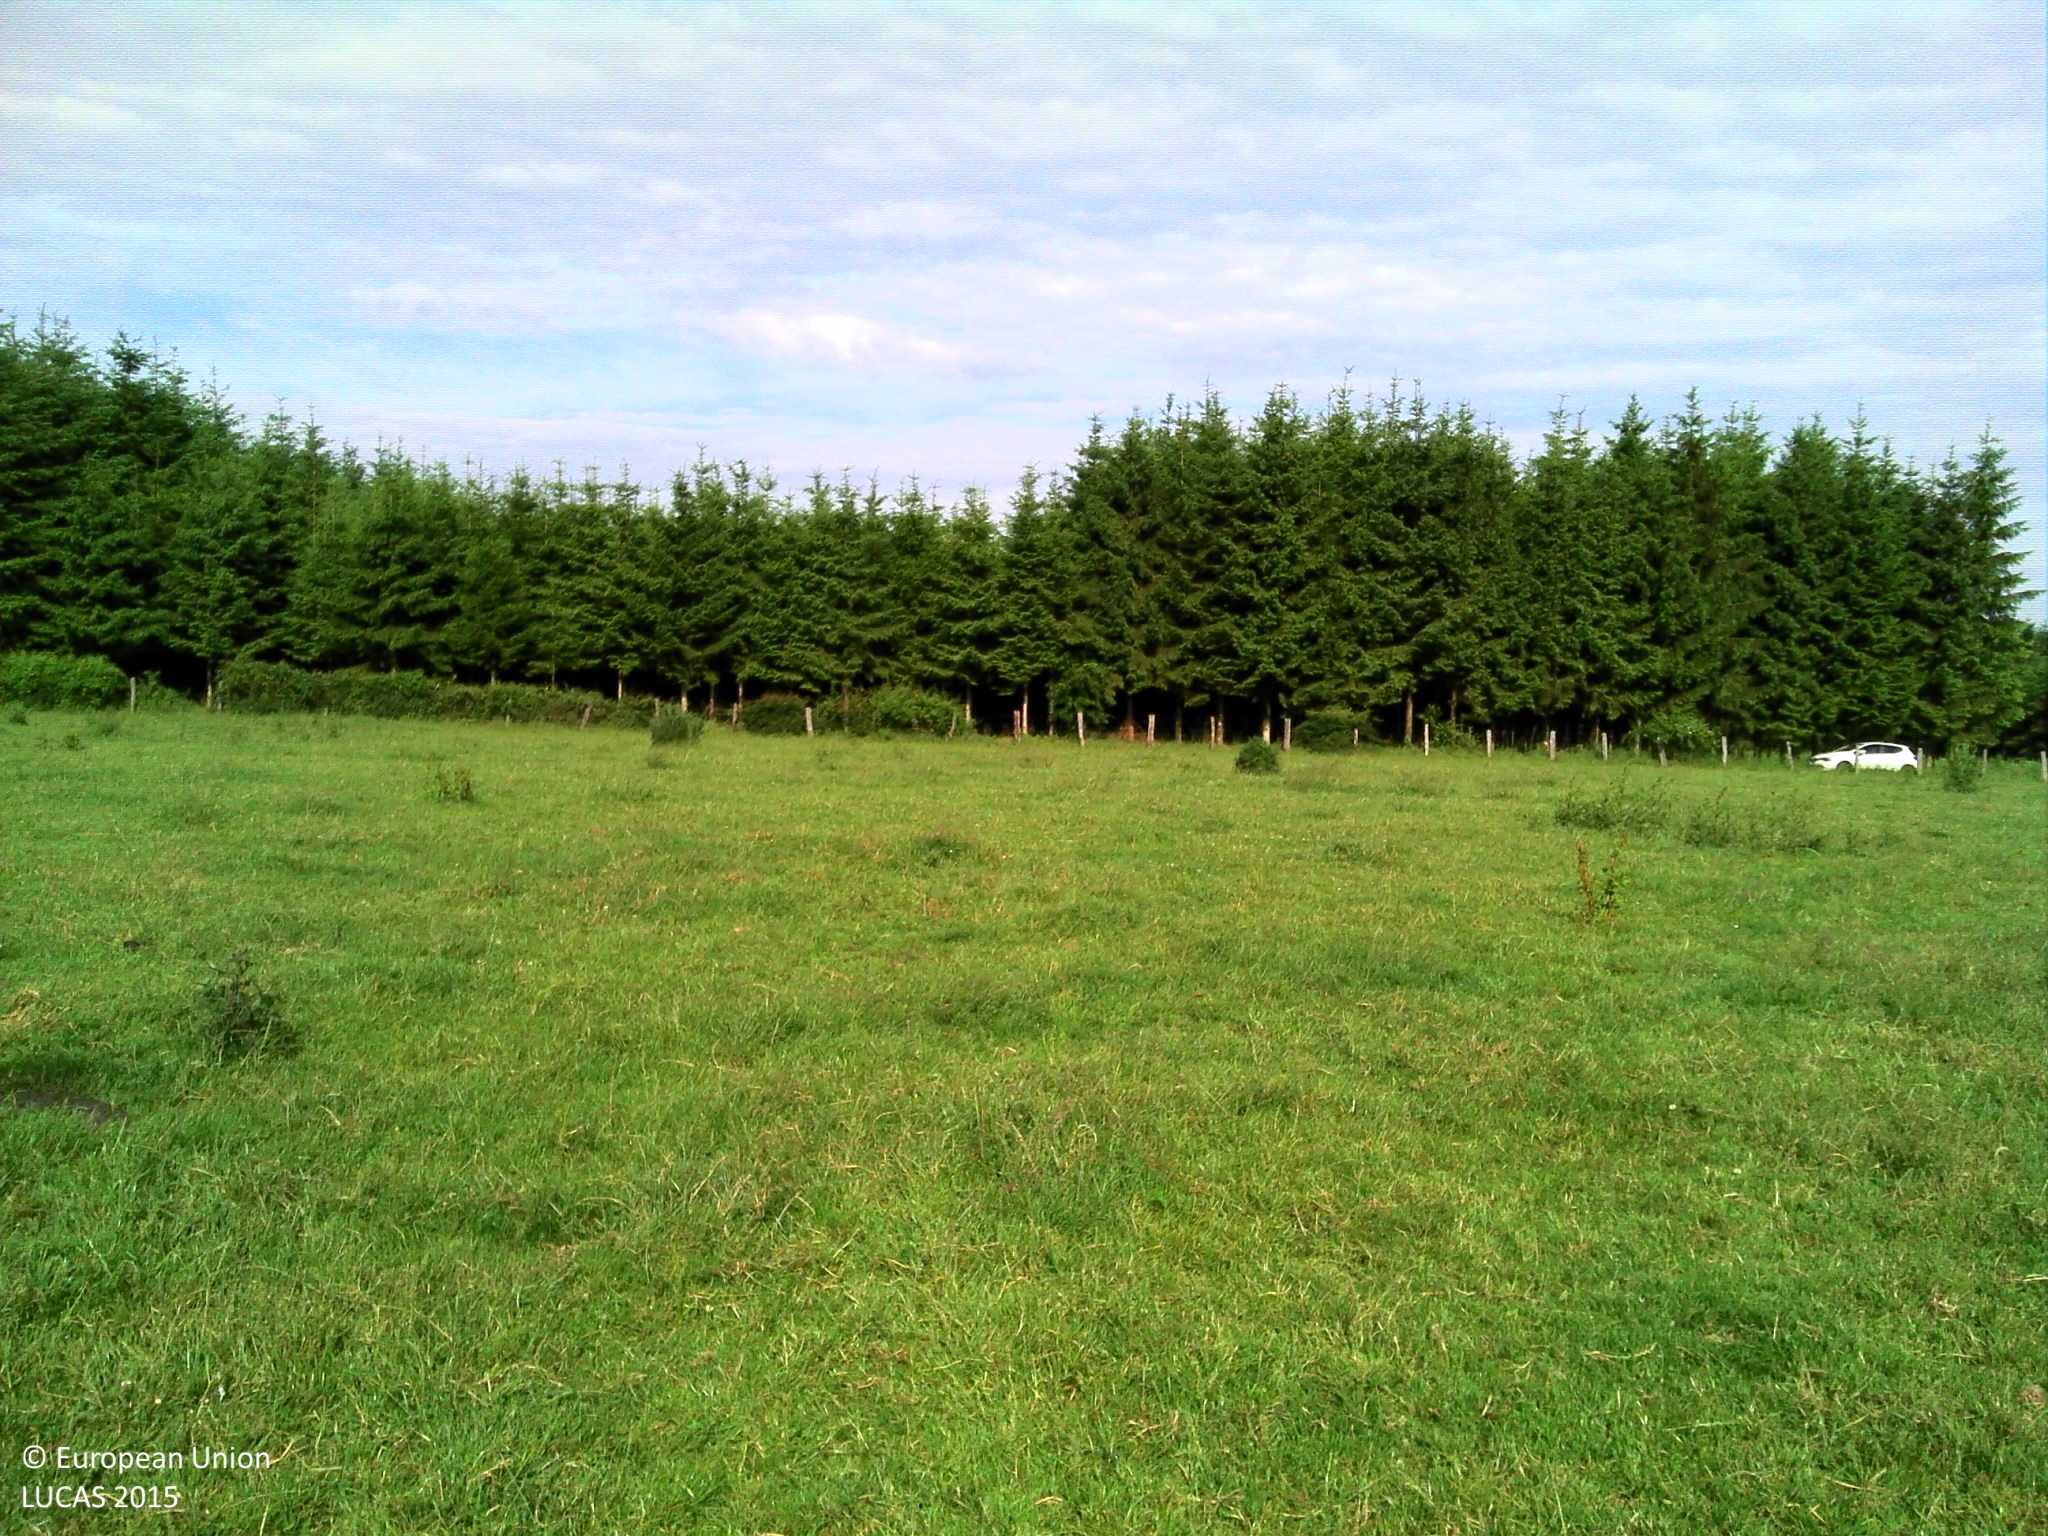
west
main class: Grassland
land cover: Grassland without tree/shrub cover
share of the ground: > 75 %
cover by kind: herbaceous plants 100 %
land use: Agriculture (excluding fallow land and kitchen gardens)
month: June
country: BE
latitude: 49.9399
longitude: 5.2185
